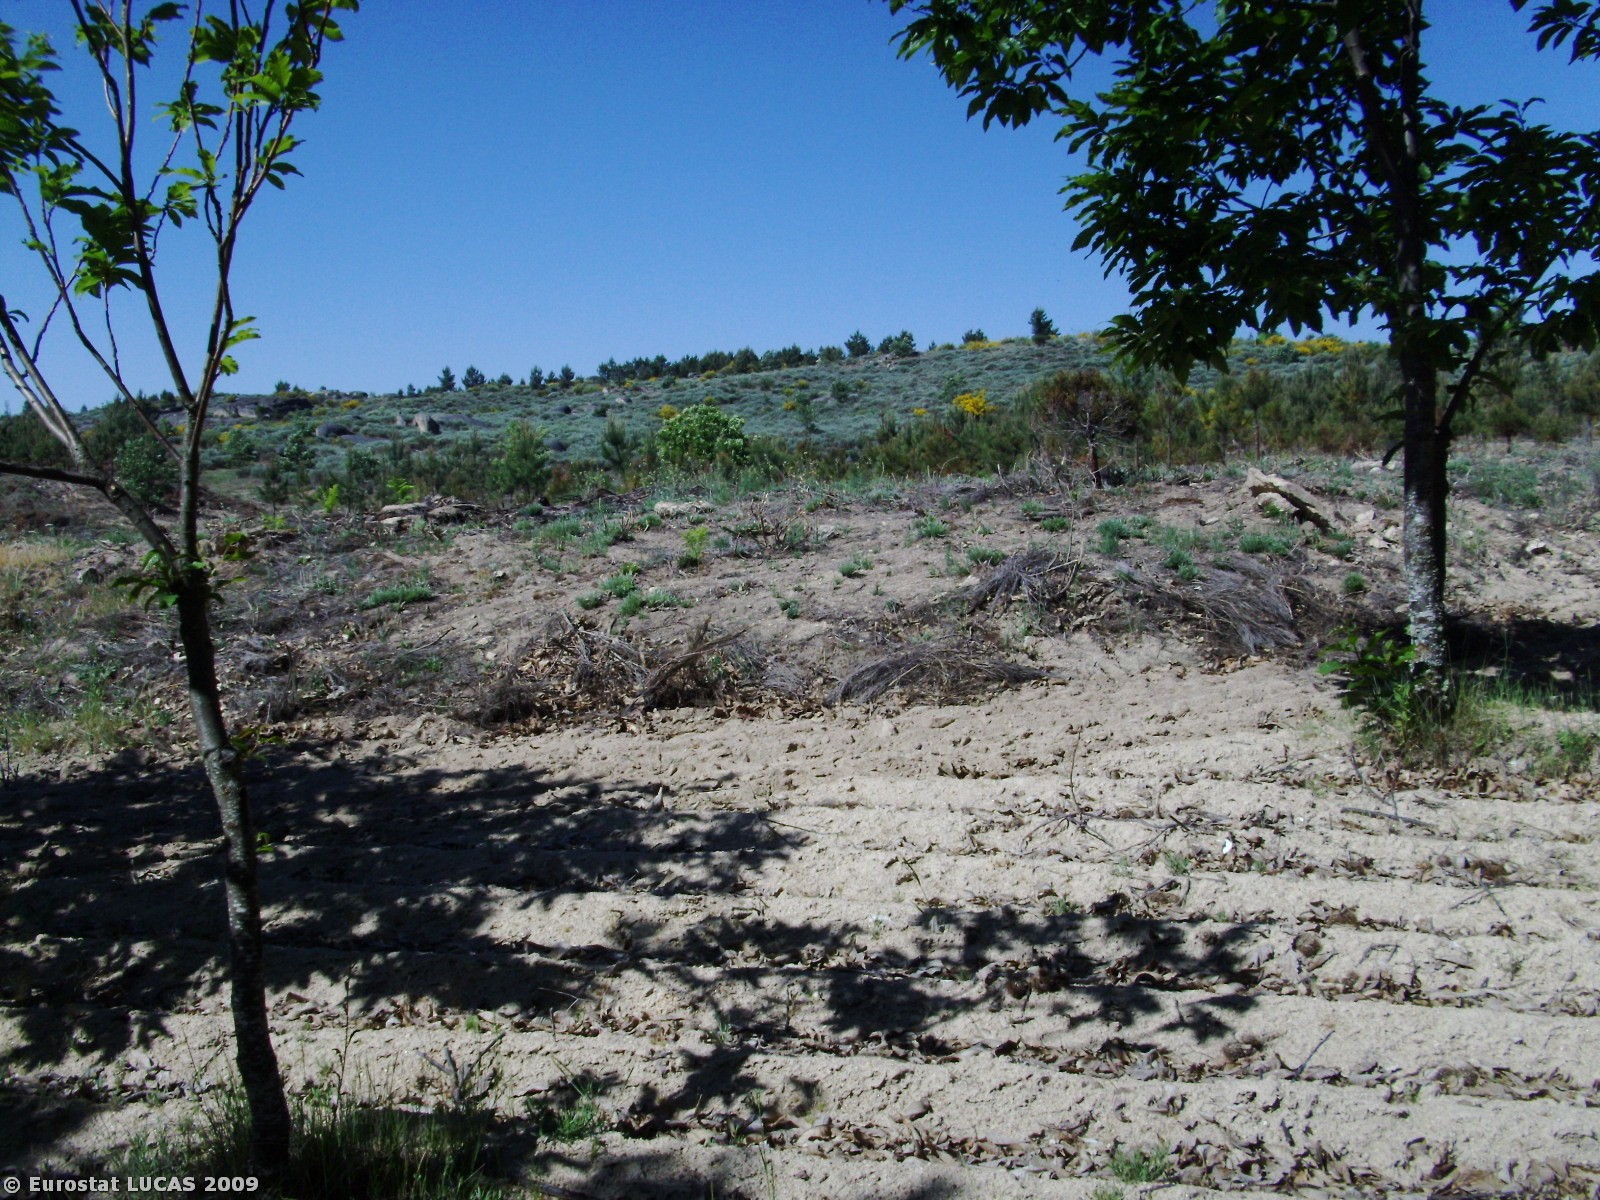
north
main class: Woodland
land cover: Broadleaved woodland
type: mesophytic deciduous forest
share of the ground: 50 - 75 %
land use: Forestry
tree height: > 5 m
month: May
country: PT
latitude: 40.8527
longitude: -7.3244
